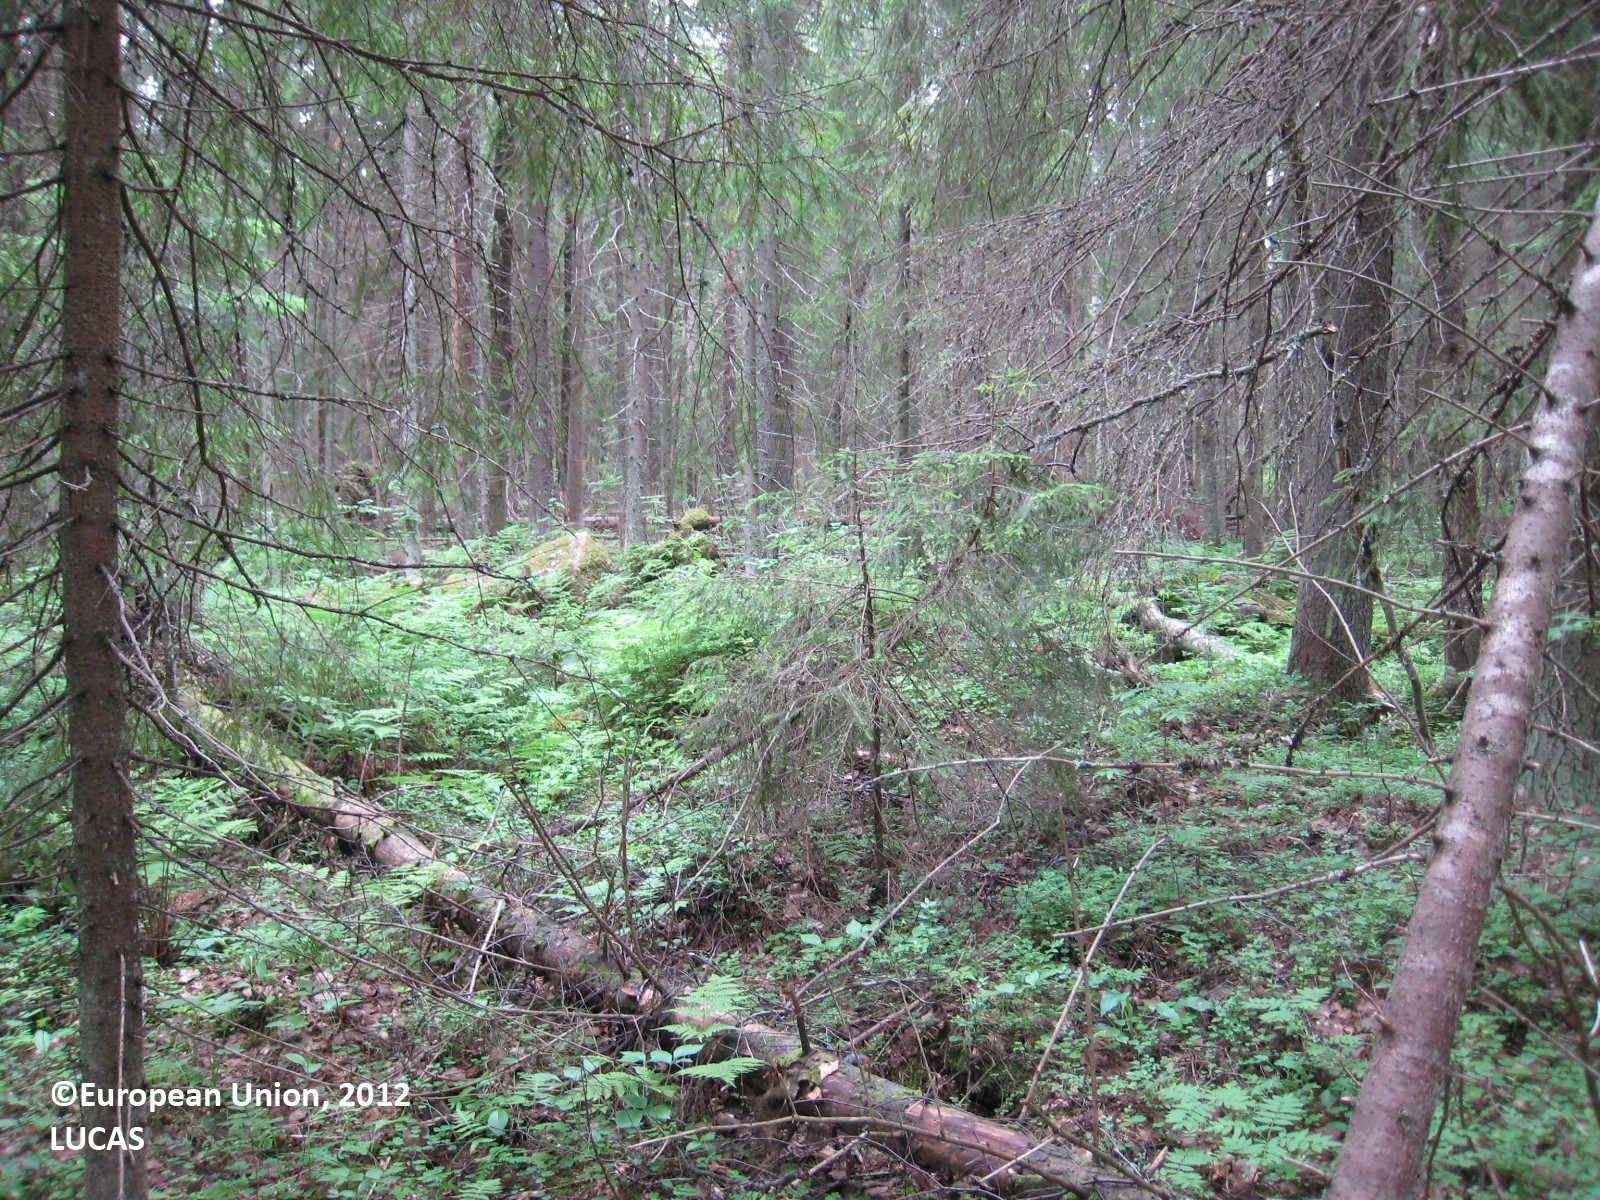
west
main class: Woodland
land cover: Spruce dominated coniferous woodland
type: boreal forest
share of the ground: 50 - 75 %
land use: Forestry
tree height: > 5 m
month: June
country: FI
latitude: 62.0653
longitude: 26.3055
